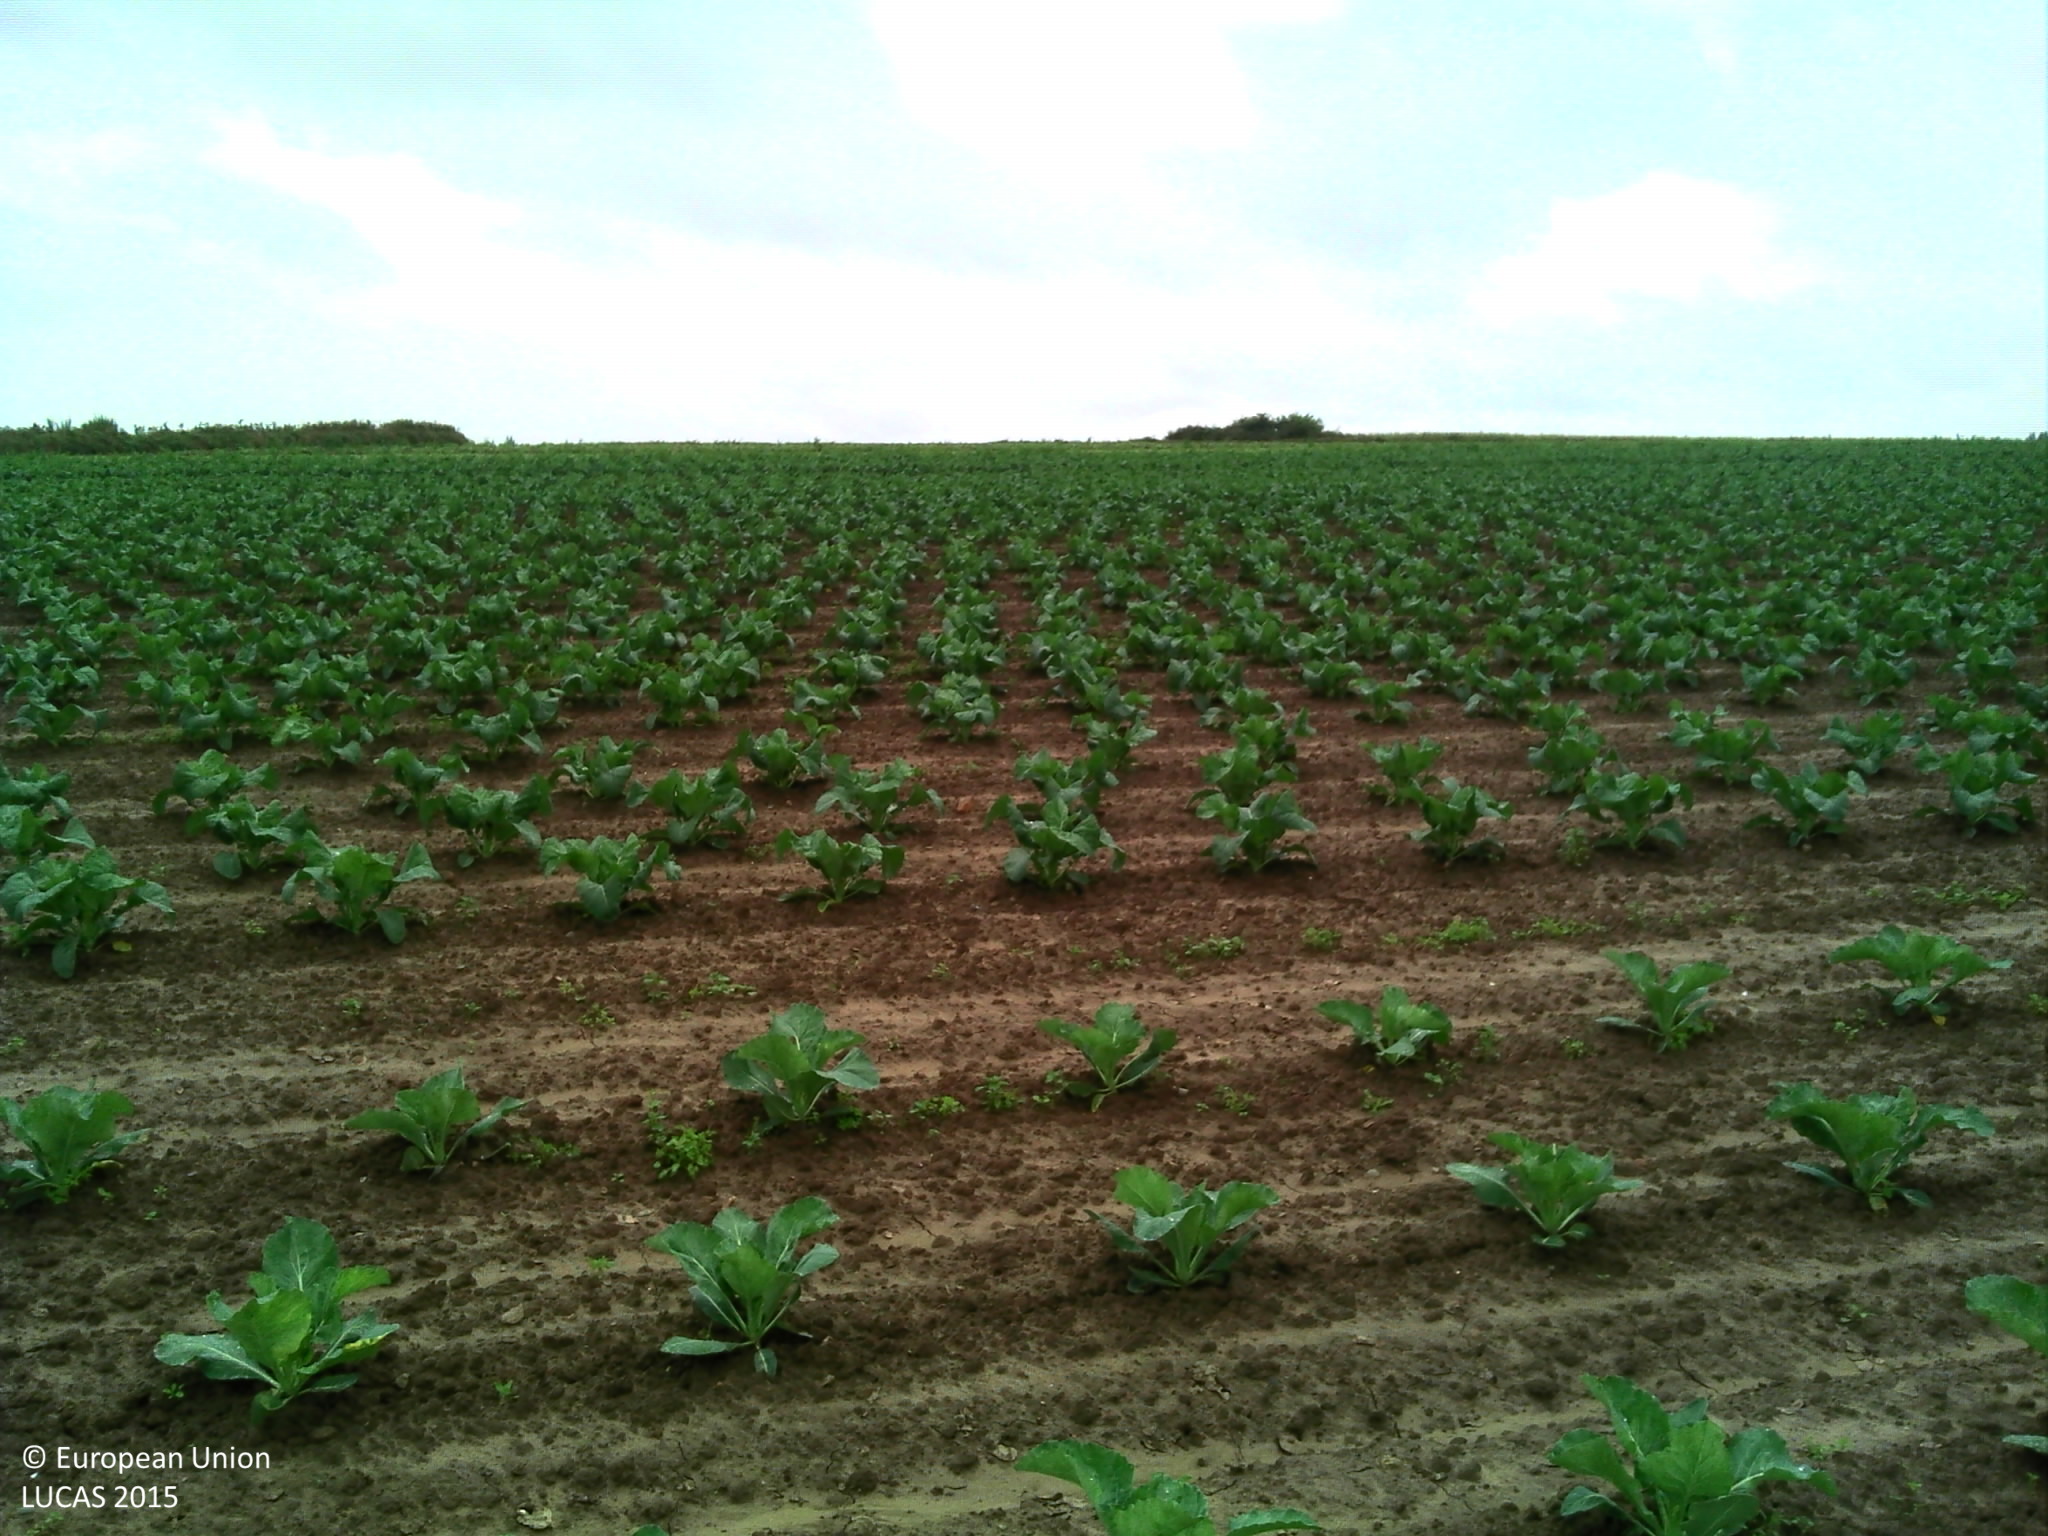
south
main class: Cropland
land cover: Other fresh vegetables
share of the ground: 10 - 25 %
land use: Agriculture (excluding fallow land and kitchen gardens)
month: August
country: FR
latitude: 48.7995
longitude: -3.2957
